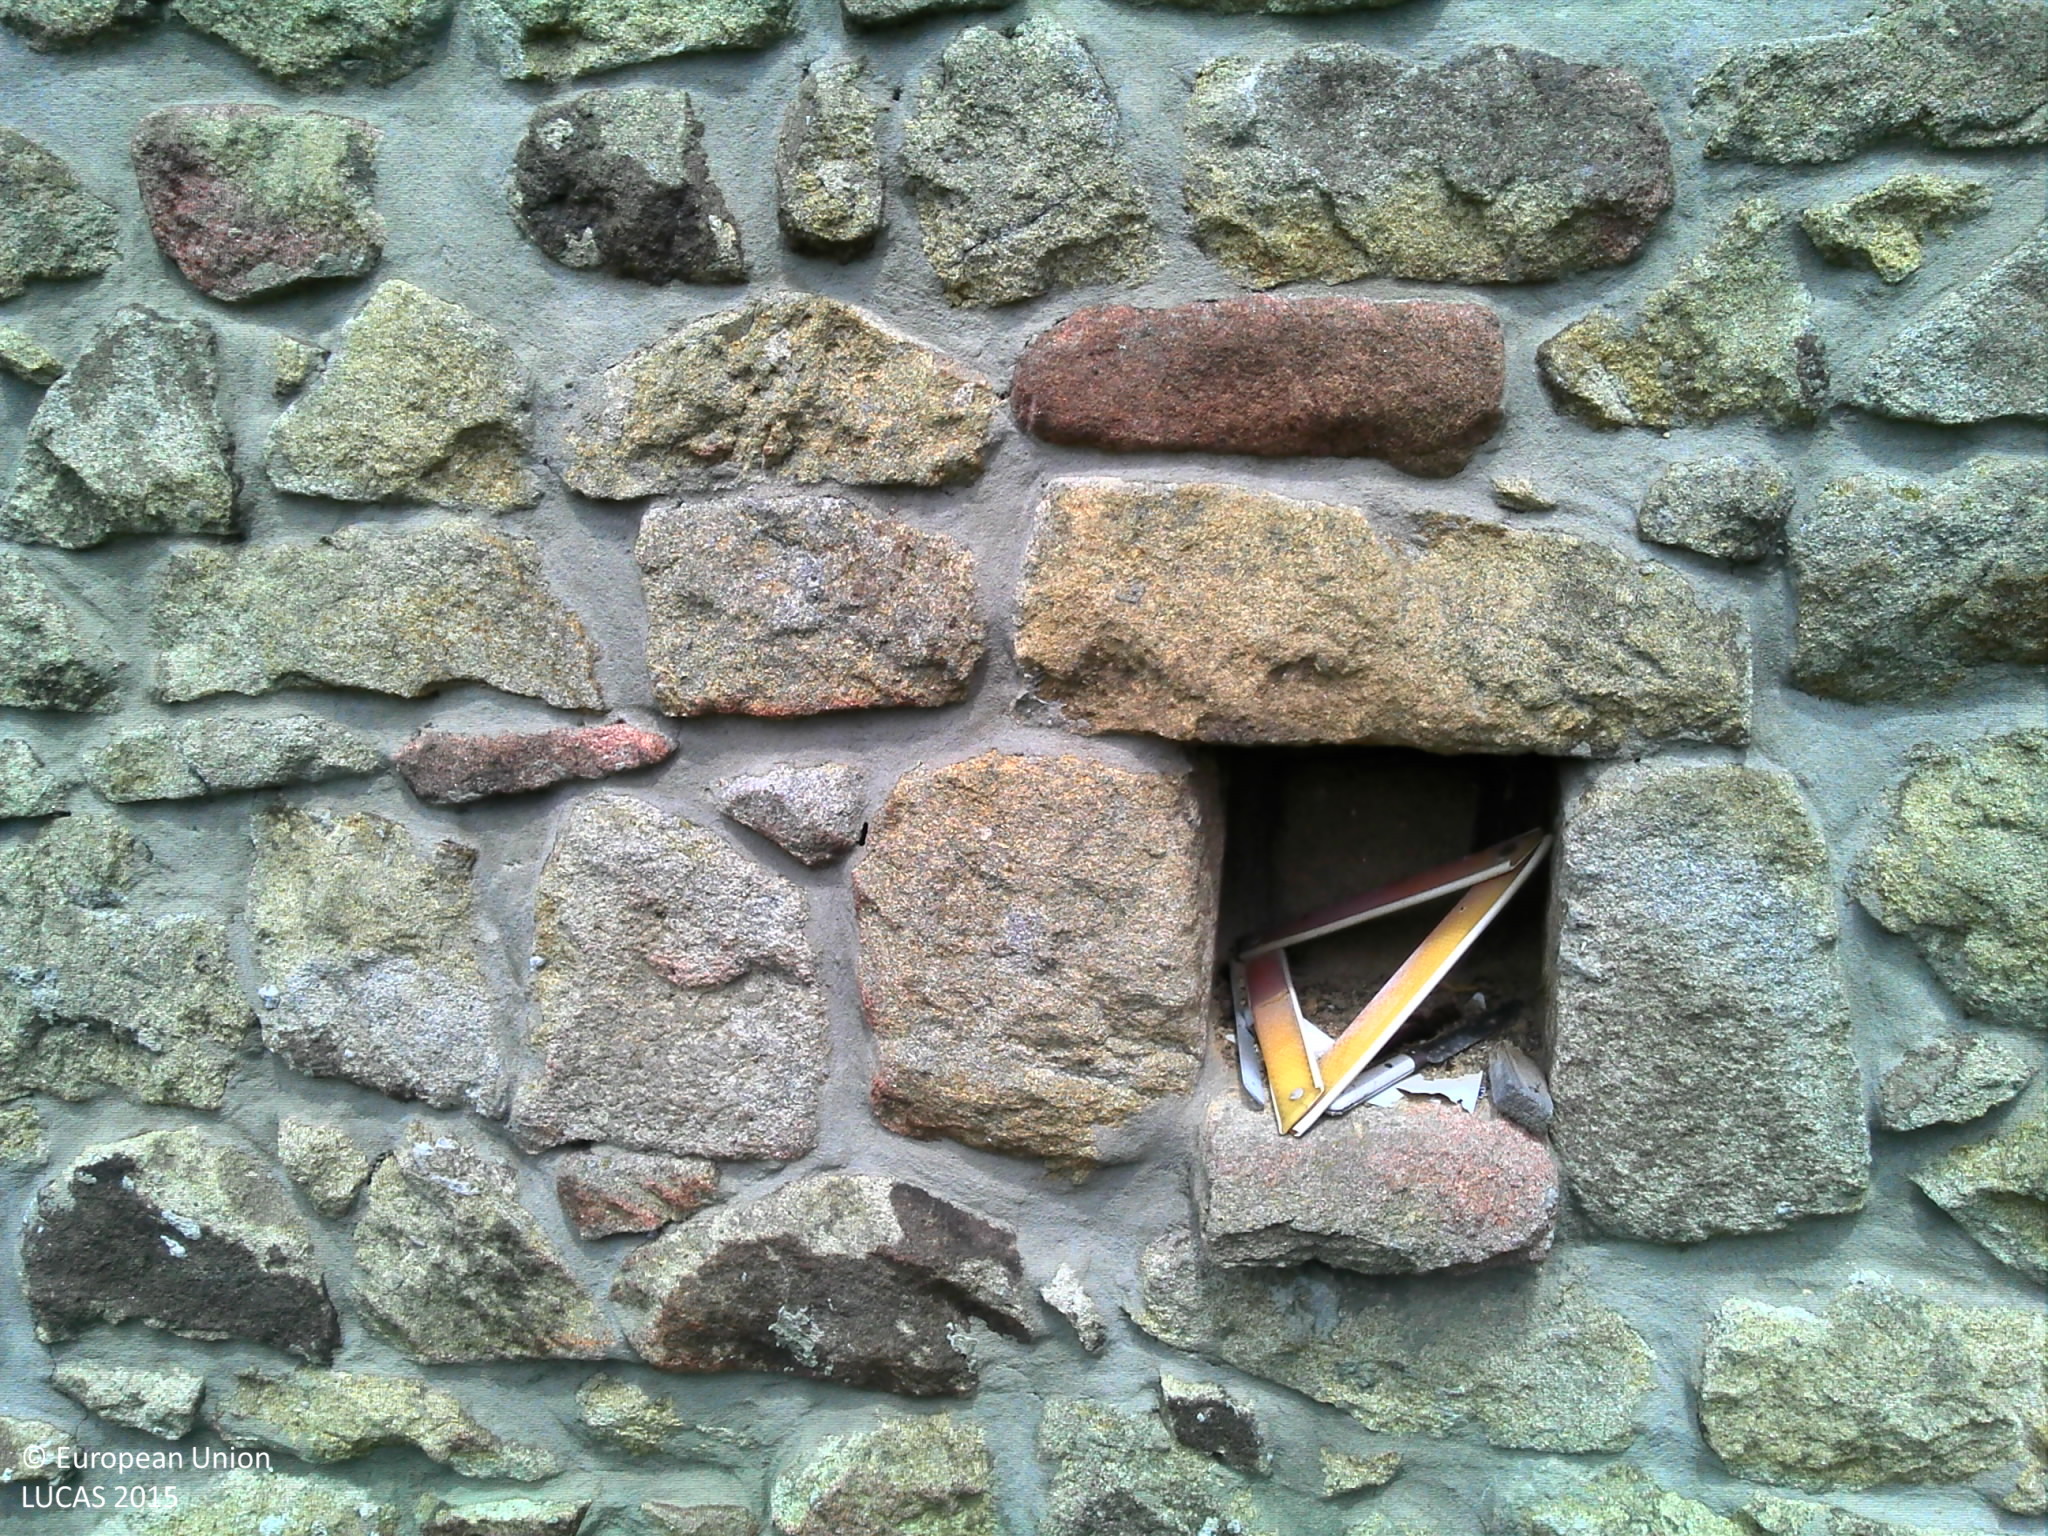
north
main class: Grassland
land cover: Grassland without tree/shrub cover
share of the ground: > 75 %
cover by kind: herbaceous plants 100 %
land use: Residential
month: August
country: FR
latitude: 45.4447
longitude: 4.7240
